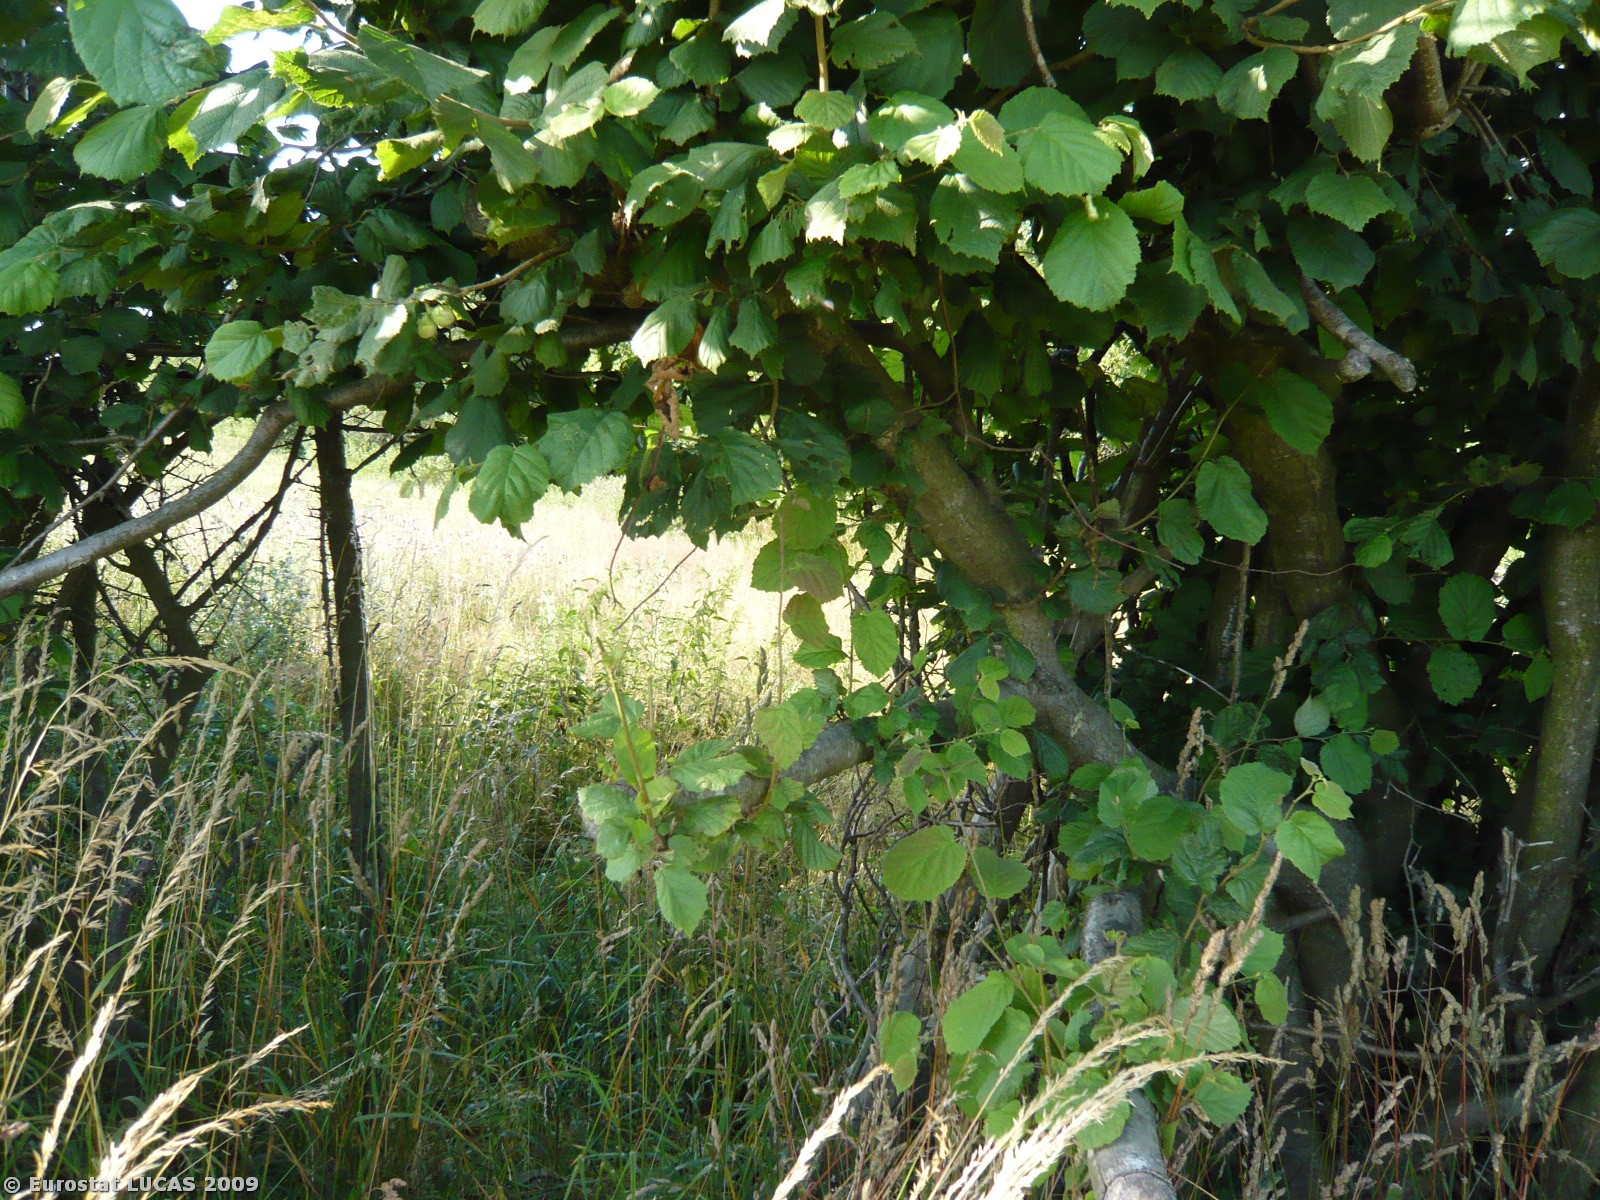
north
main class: Cropland
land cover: Common wheat
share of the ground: > 75 %
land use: Agriculture (excluding fallow land and kitchen gardens)
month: July
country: DK
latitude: 55.6043
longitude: 11.4431
